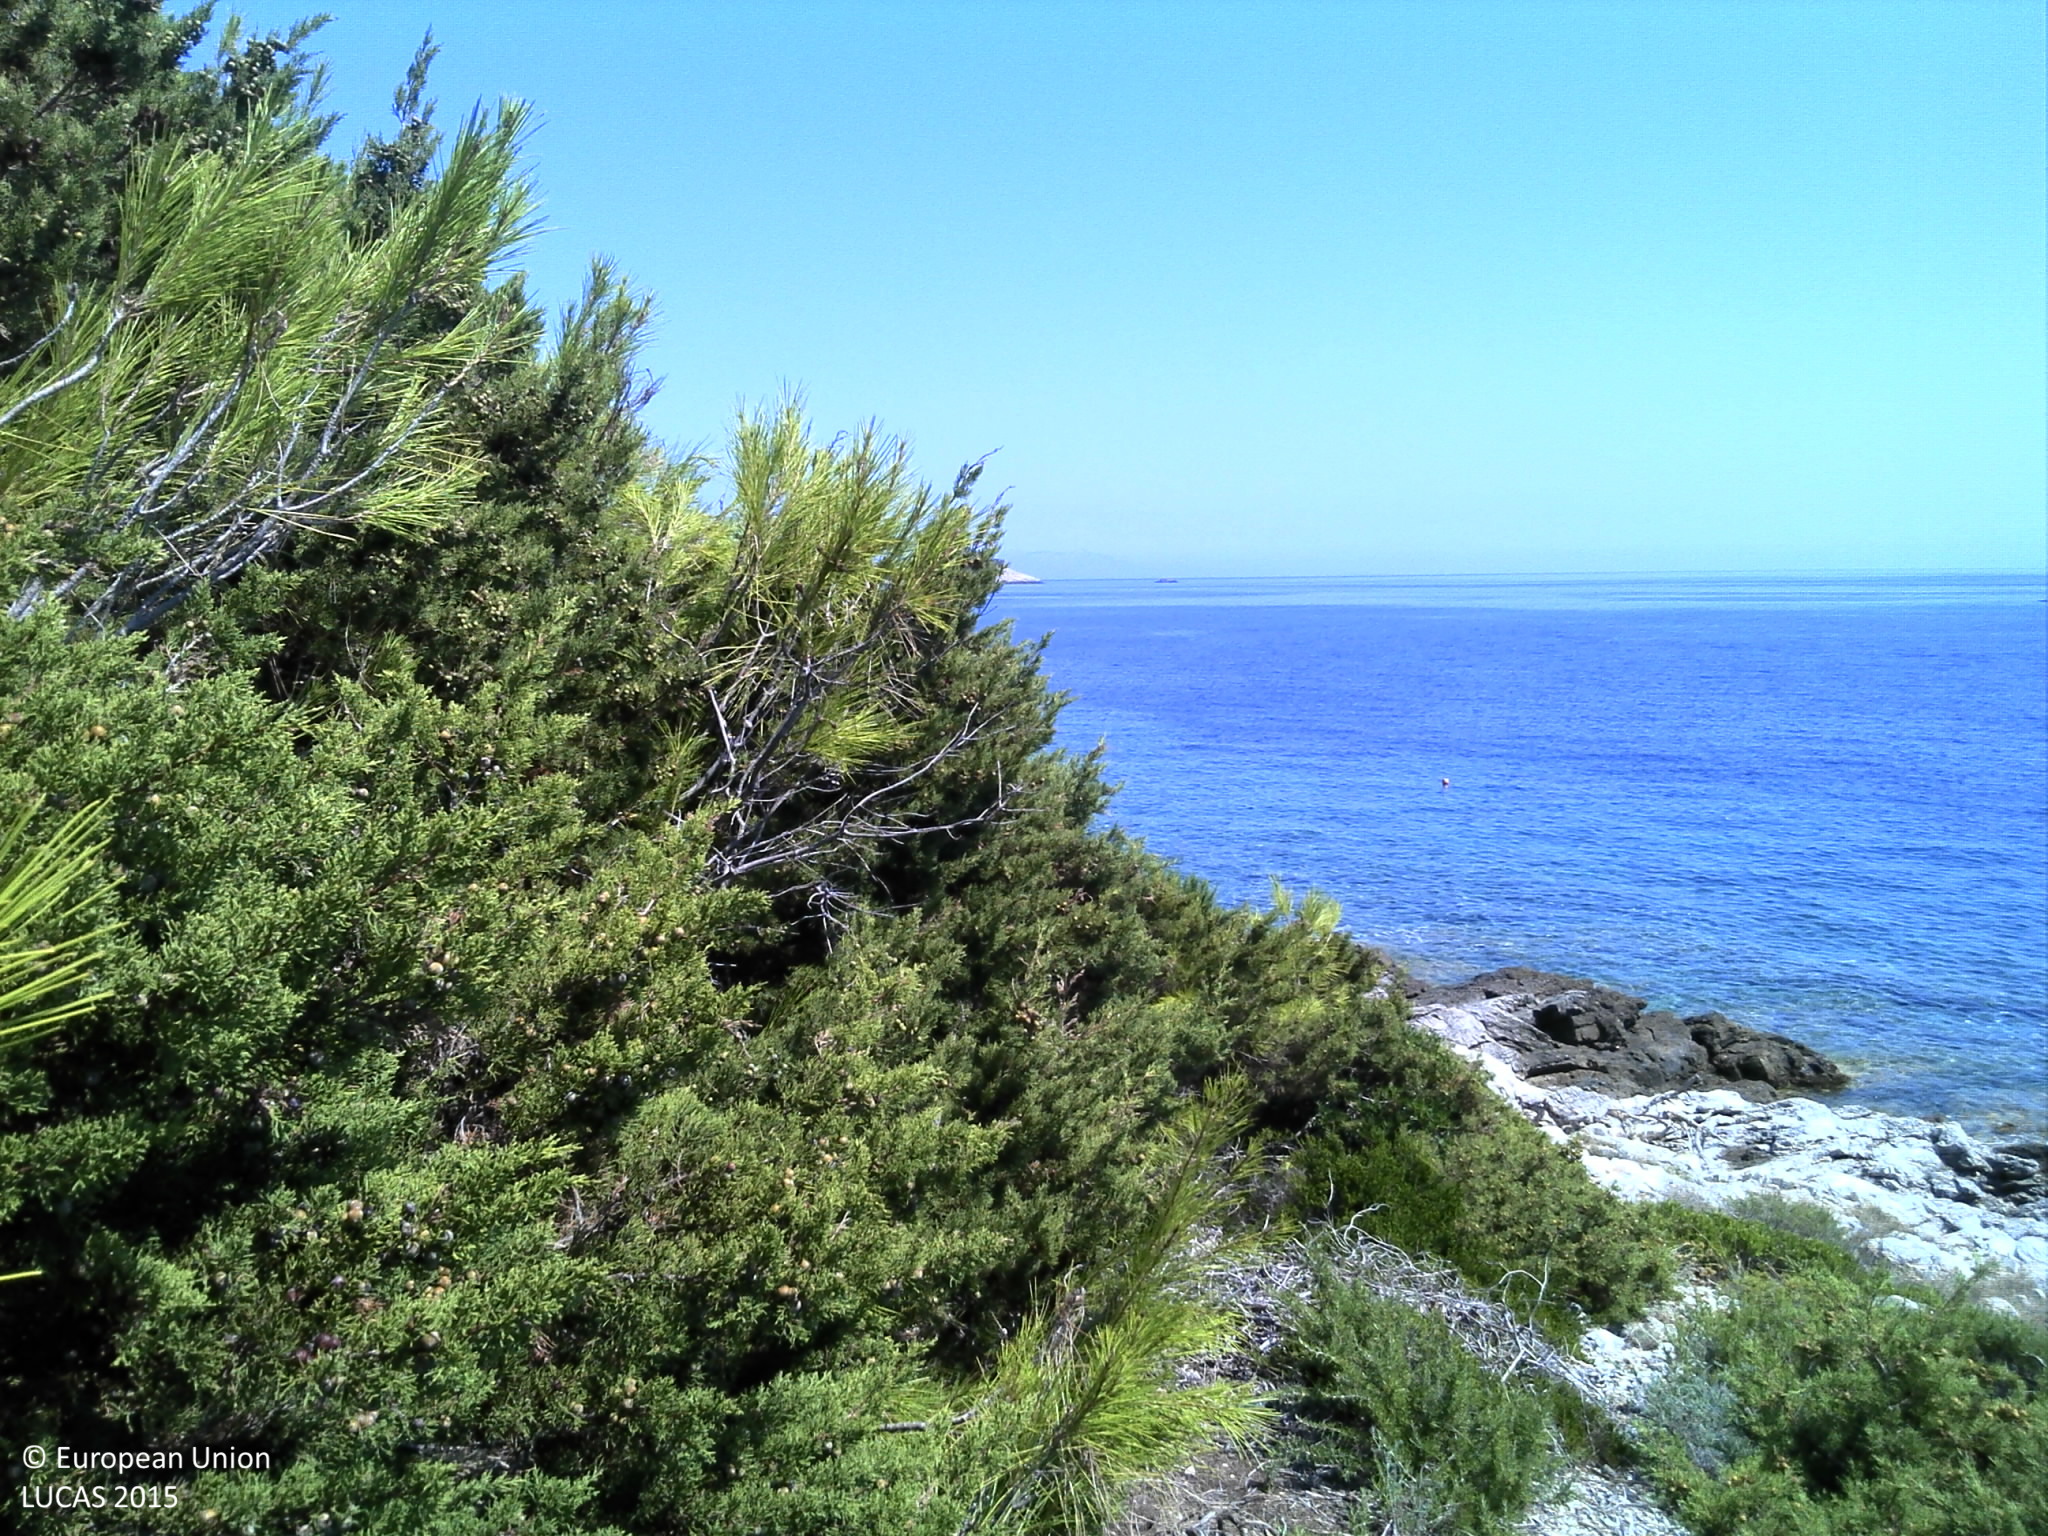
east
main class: Shrubland
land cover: Shrubland with sparse tree cover
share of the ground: > 75 %
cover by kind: shrubs 70 %, unconsolidated bare surface 15 %, coniferous forest trees 5 %, herbaceous plants 5 %, consolidated bare surface 5 %
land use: Semi-natural and natural areas not in use
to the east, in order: Shrubland with sparse tree cover; Rocks and stones
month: August
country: HR
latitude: 43.0411
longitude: 16.2365
